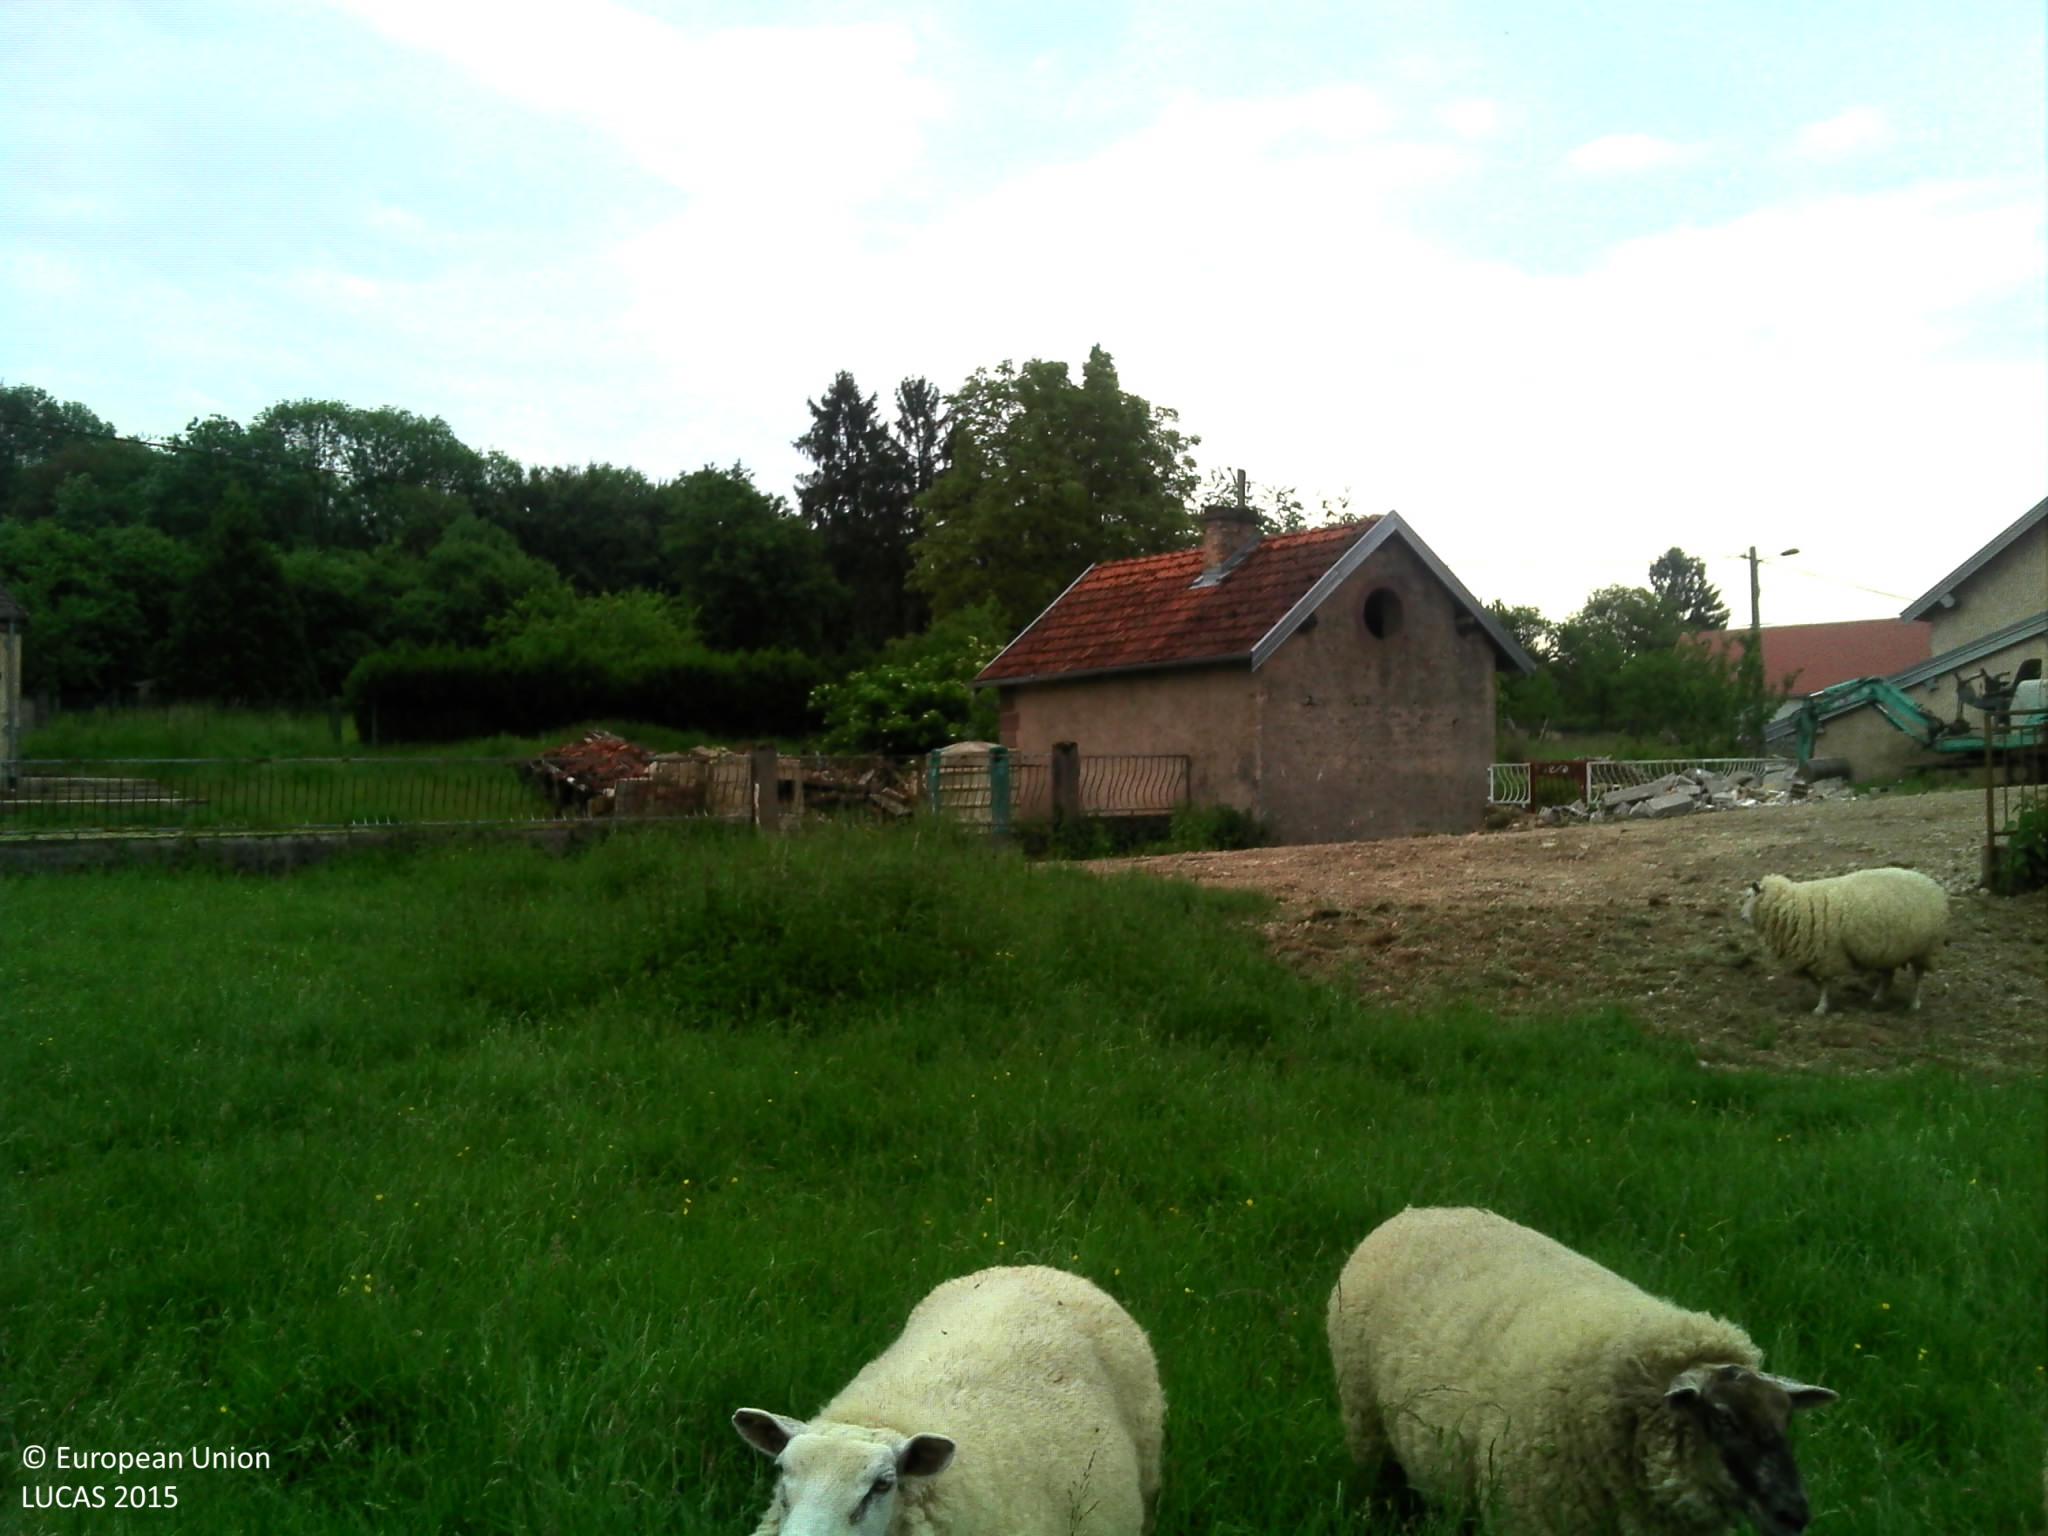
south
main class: Grassland
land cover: Grassland without tree/shrub cover
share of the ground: > 75 %
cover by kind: herbaceous plants 100 %
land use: Agriculture (excluding fallow land and kitchen gardens)
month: May
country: FR
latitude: 47.9216
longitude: 6.1333
